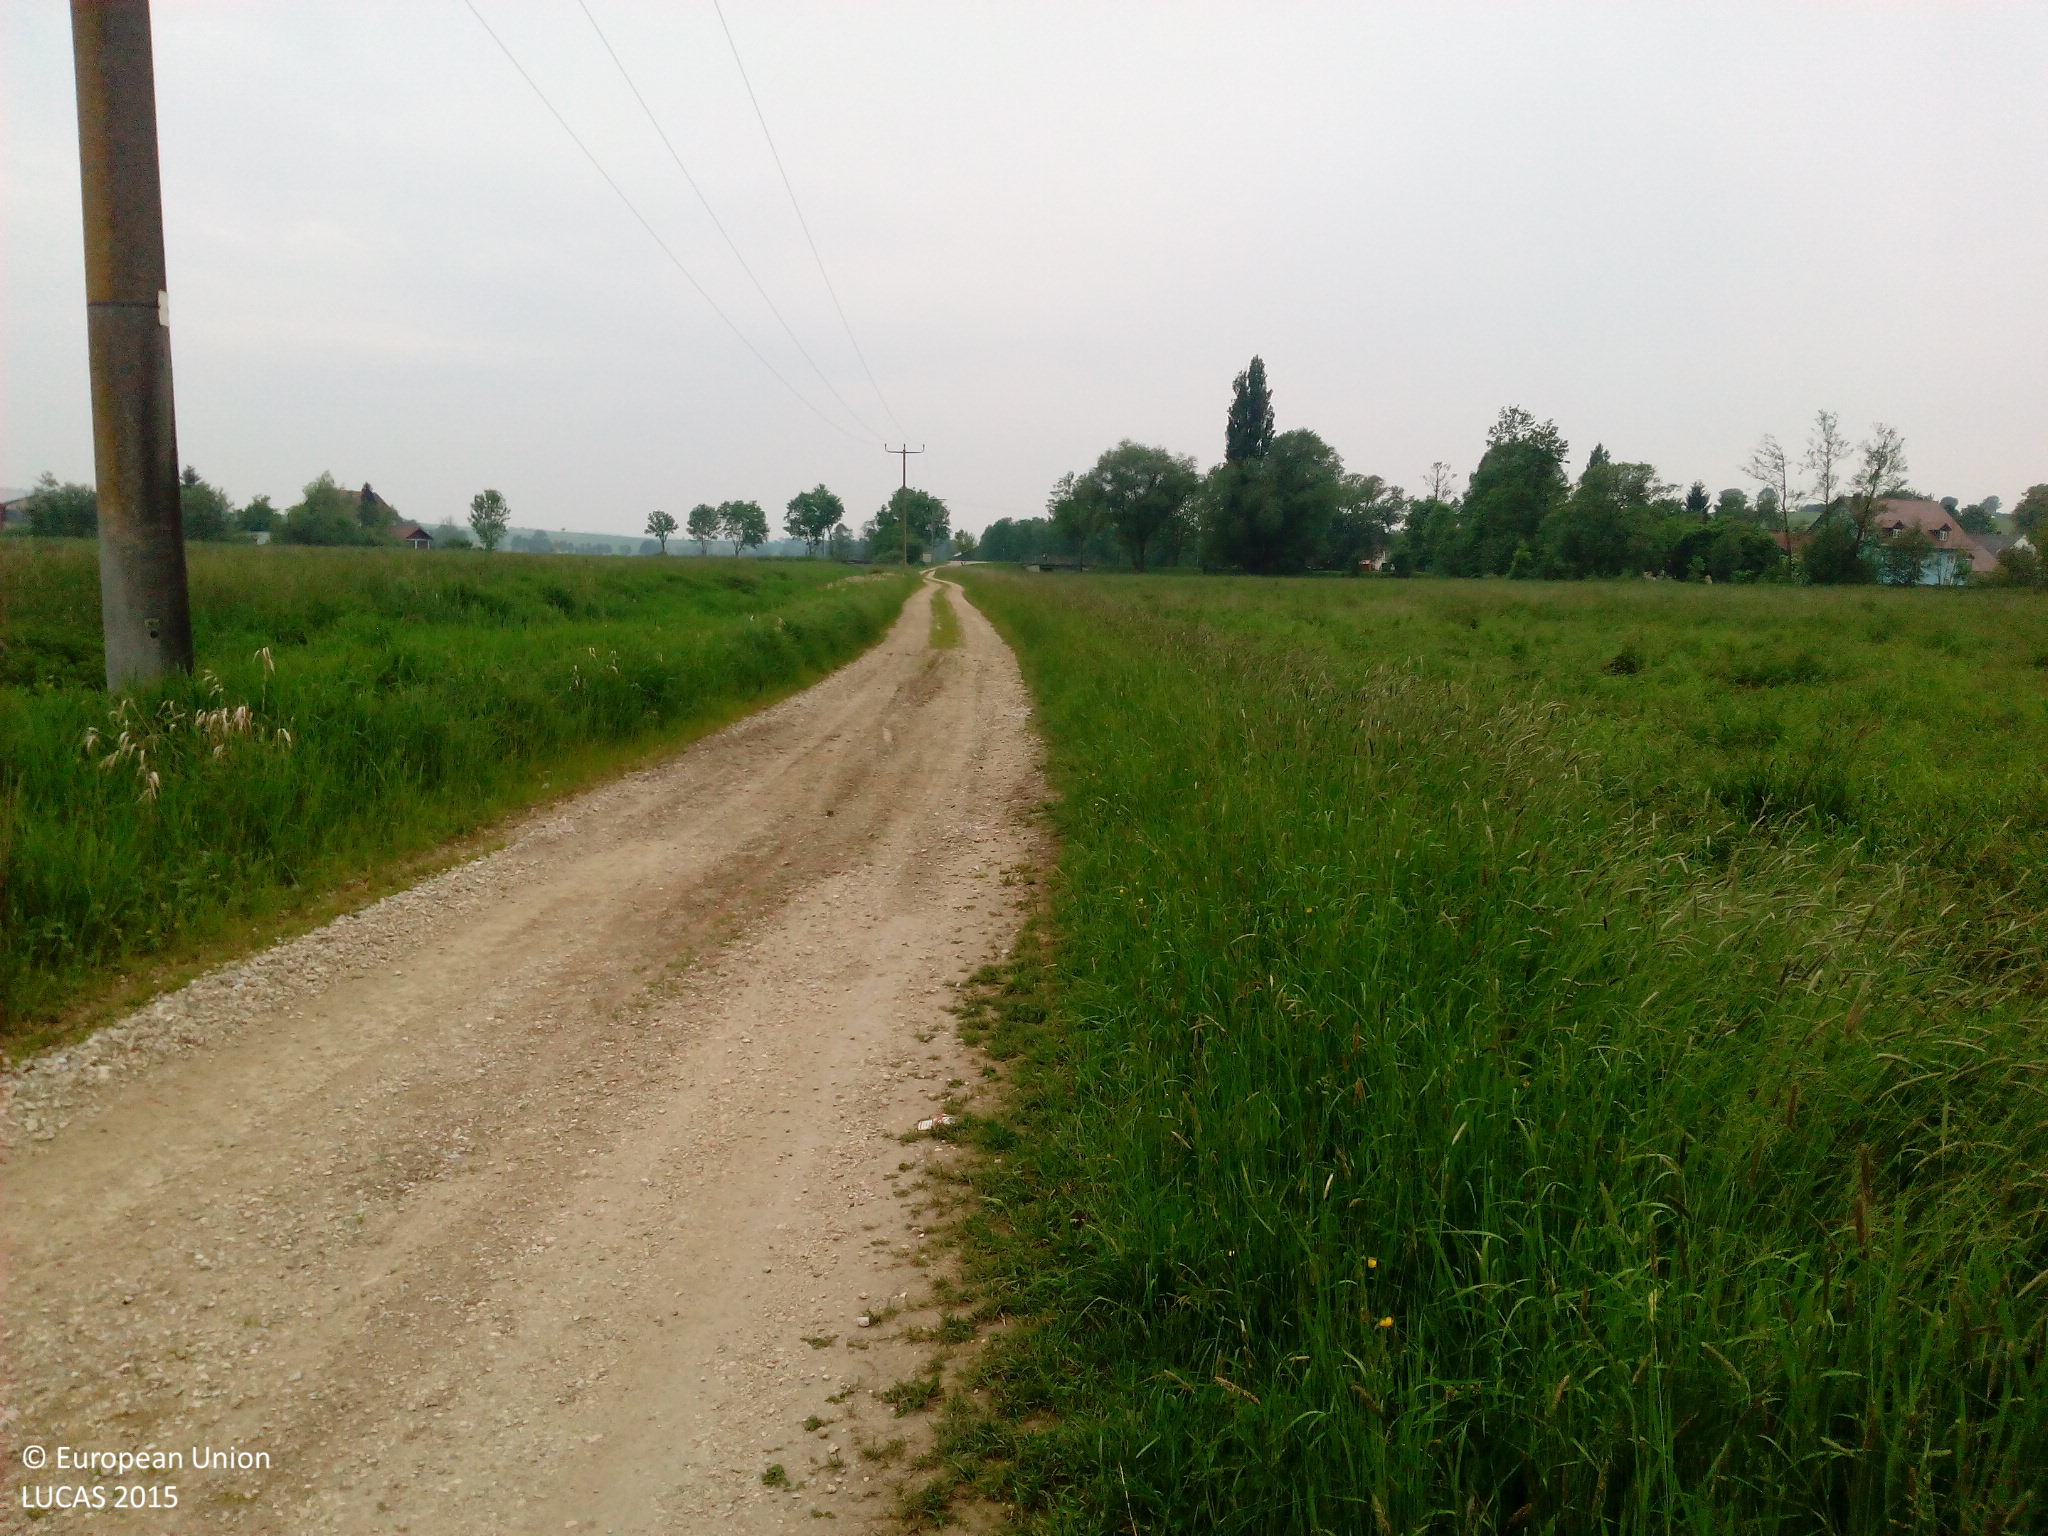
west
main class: Grassland
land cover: Grassland without tree/shrub cover
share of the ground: > 75 %
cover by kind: herbaceous plants 100 %
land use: Agriculture (excluding fallow land and kitchen gardens)
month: May
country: DE
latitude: 48.8492
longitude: 12.2206
